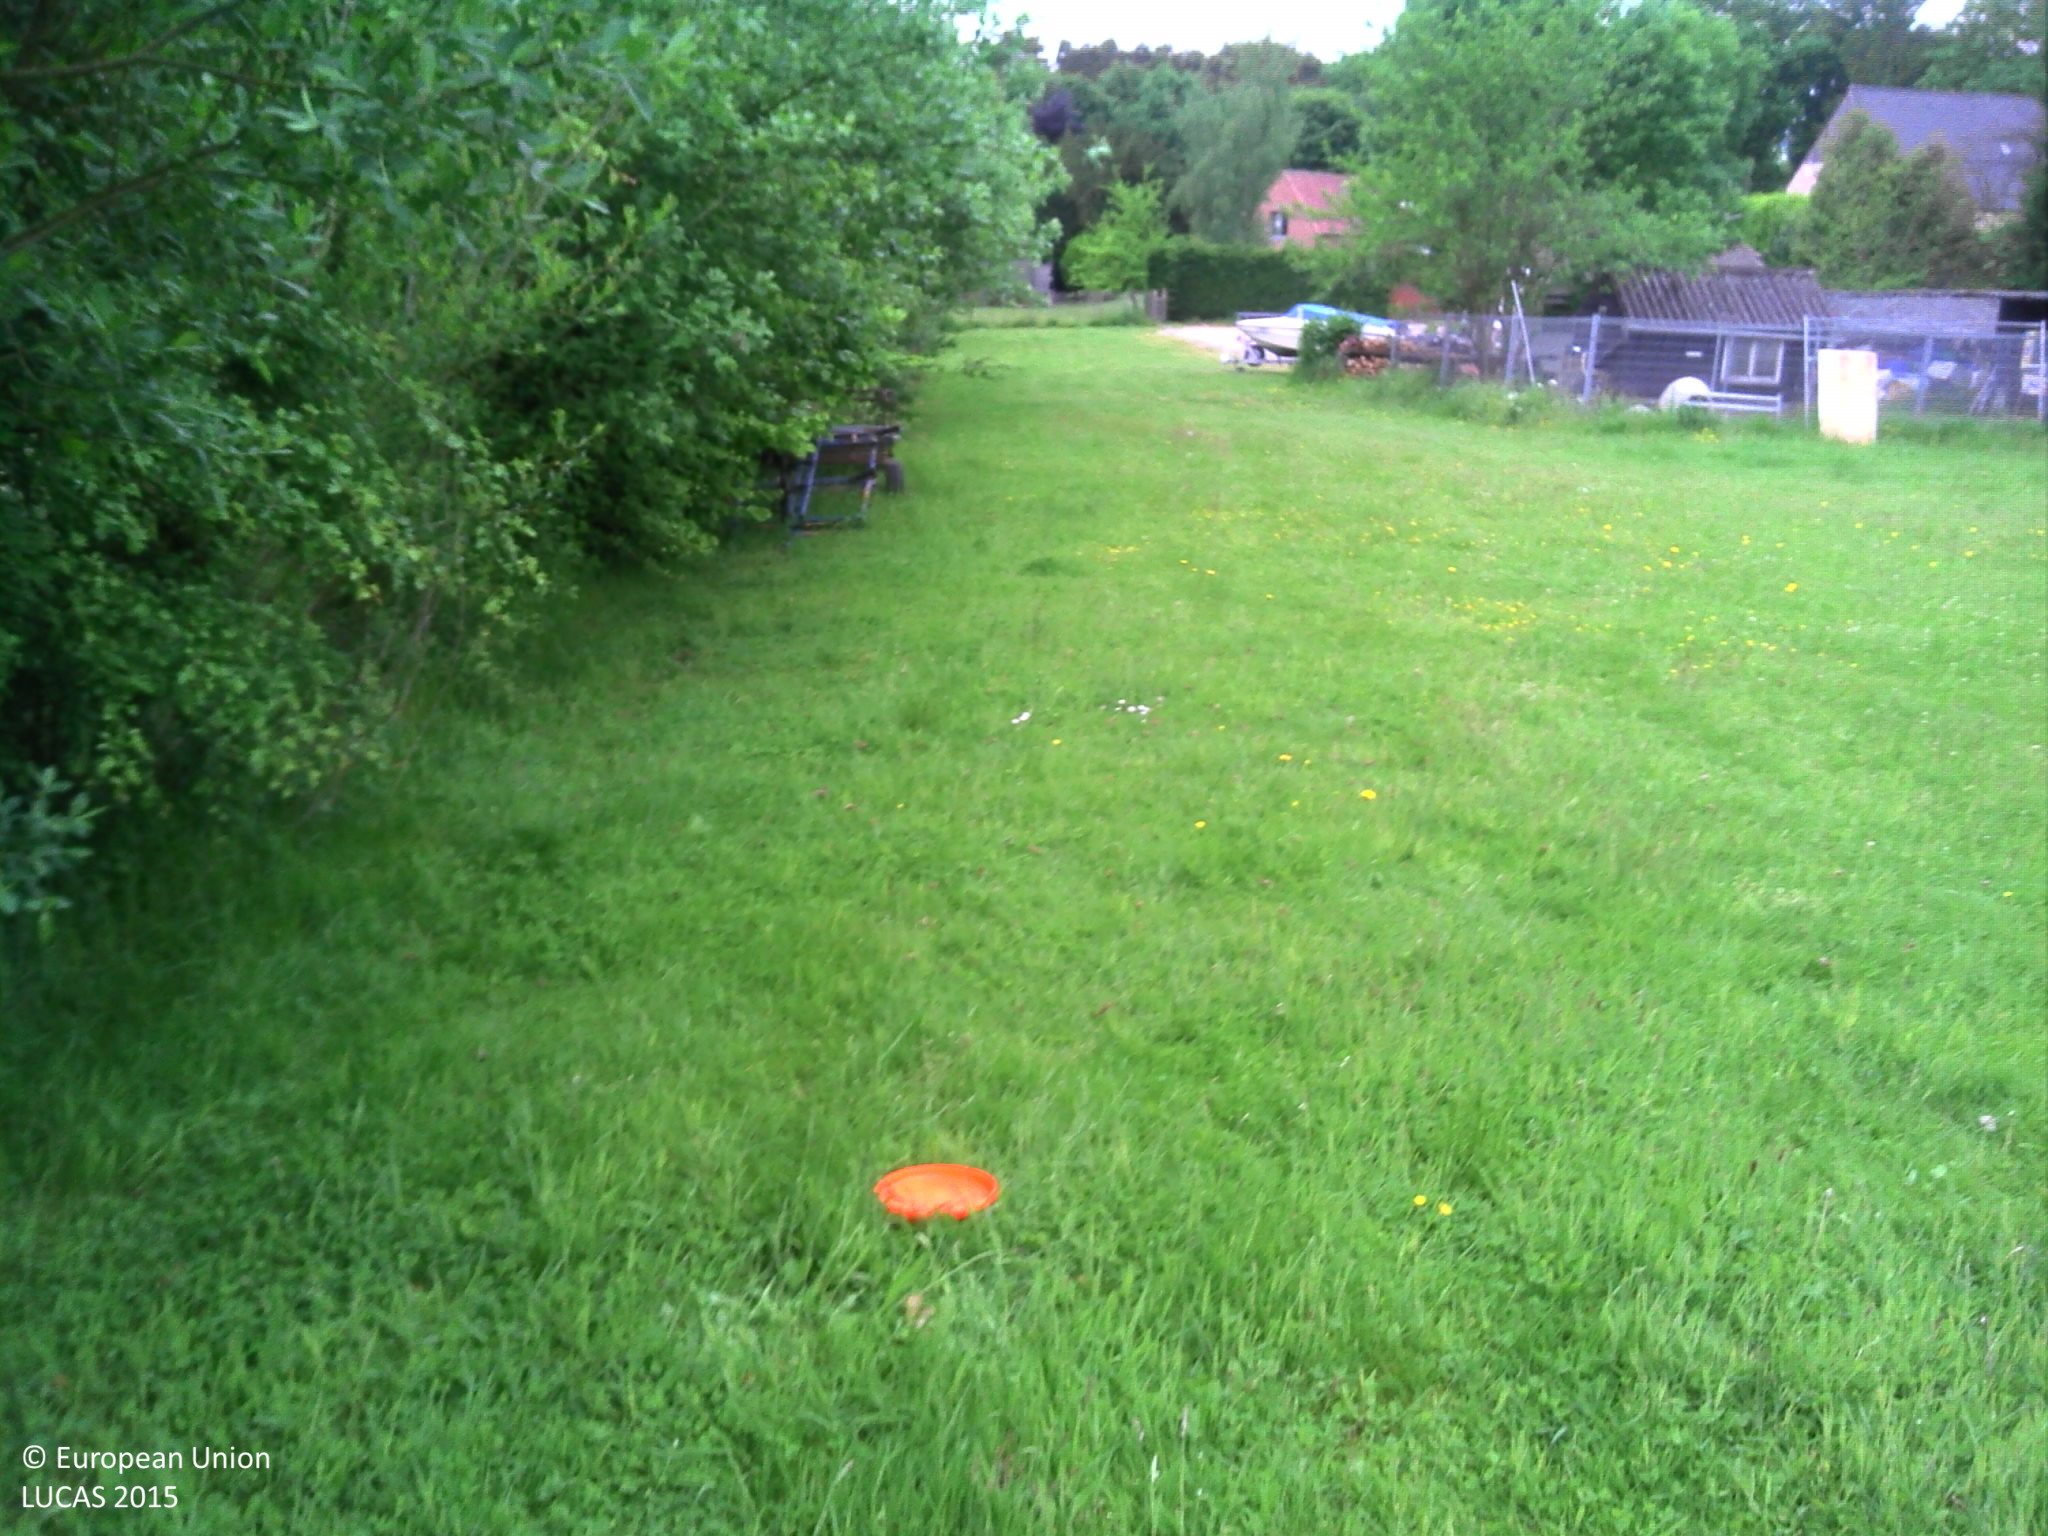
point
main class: Grassland
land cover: Grassland without tree/shrub cover
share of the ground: > 75 %
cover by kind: herbaceous plants 100 %
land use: Agriculture (excluding fallow land and kitchen gardens)
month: May
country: BE
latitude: 50.7011
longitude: 4.5164
